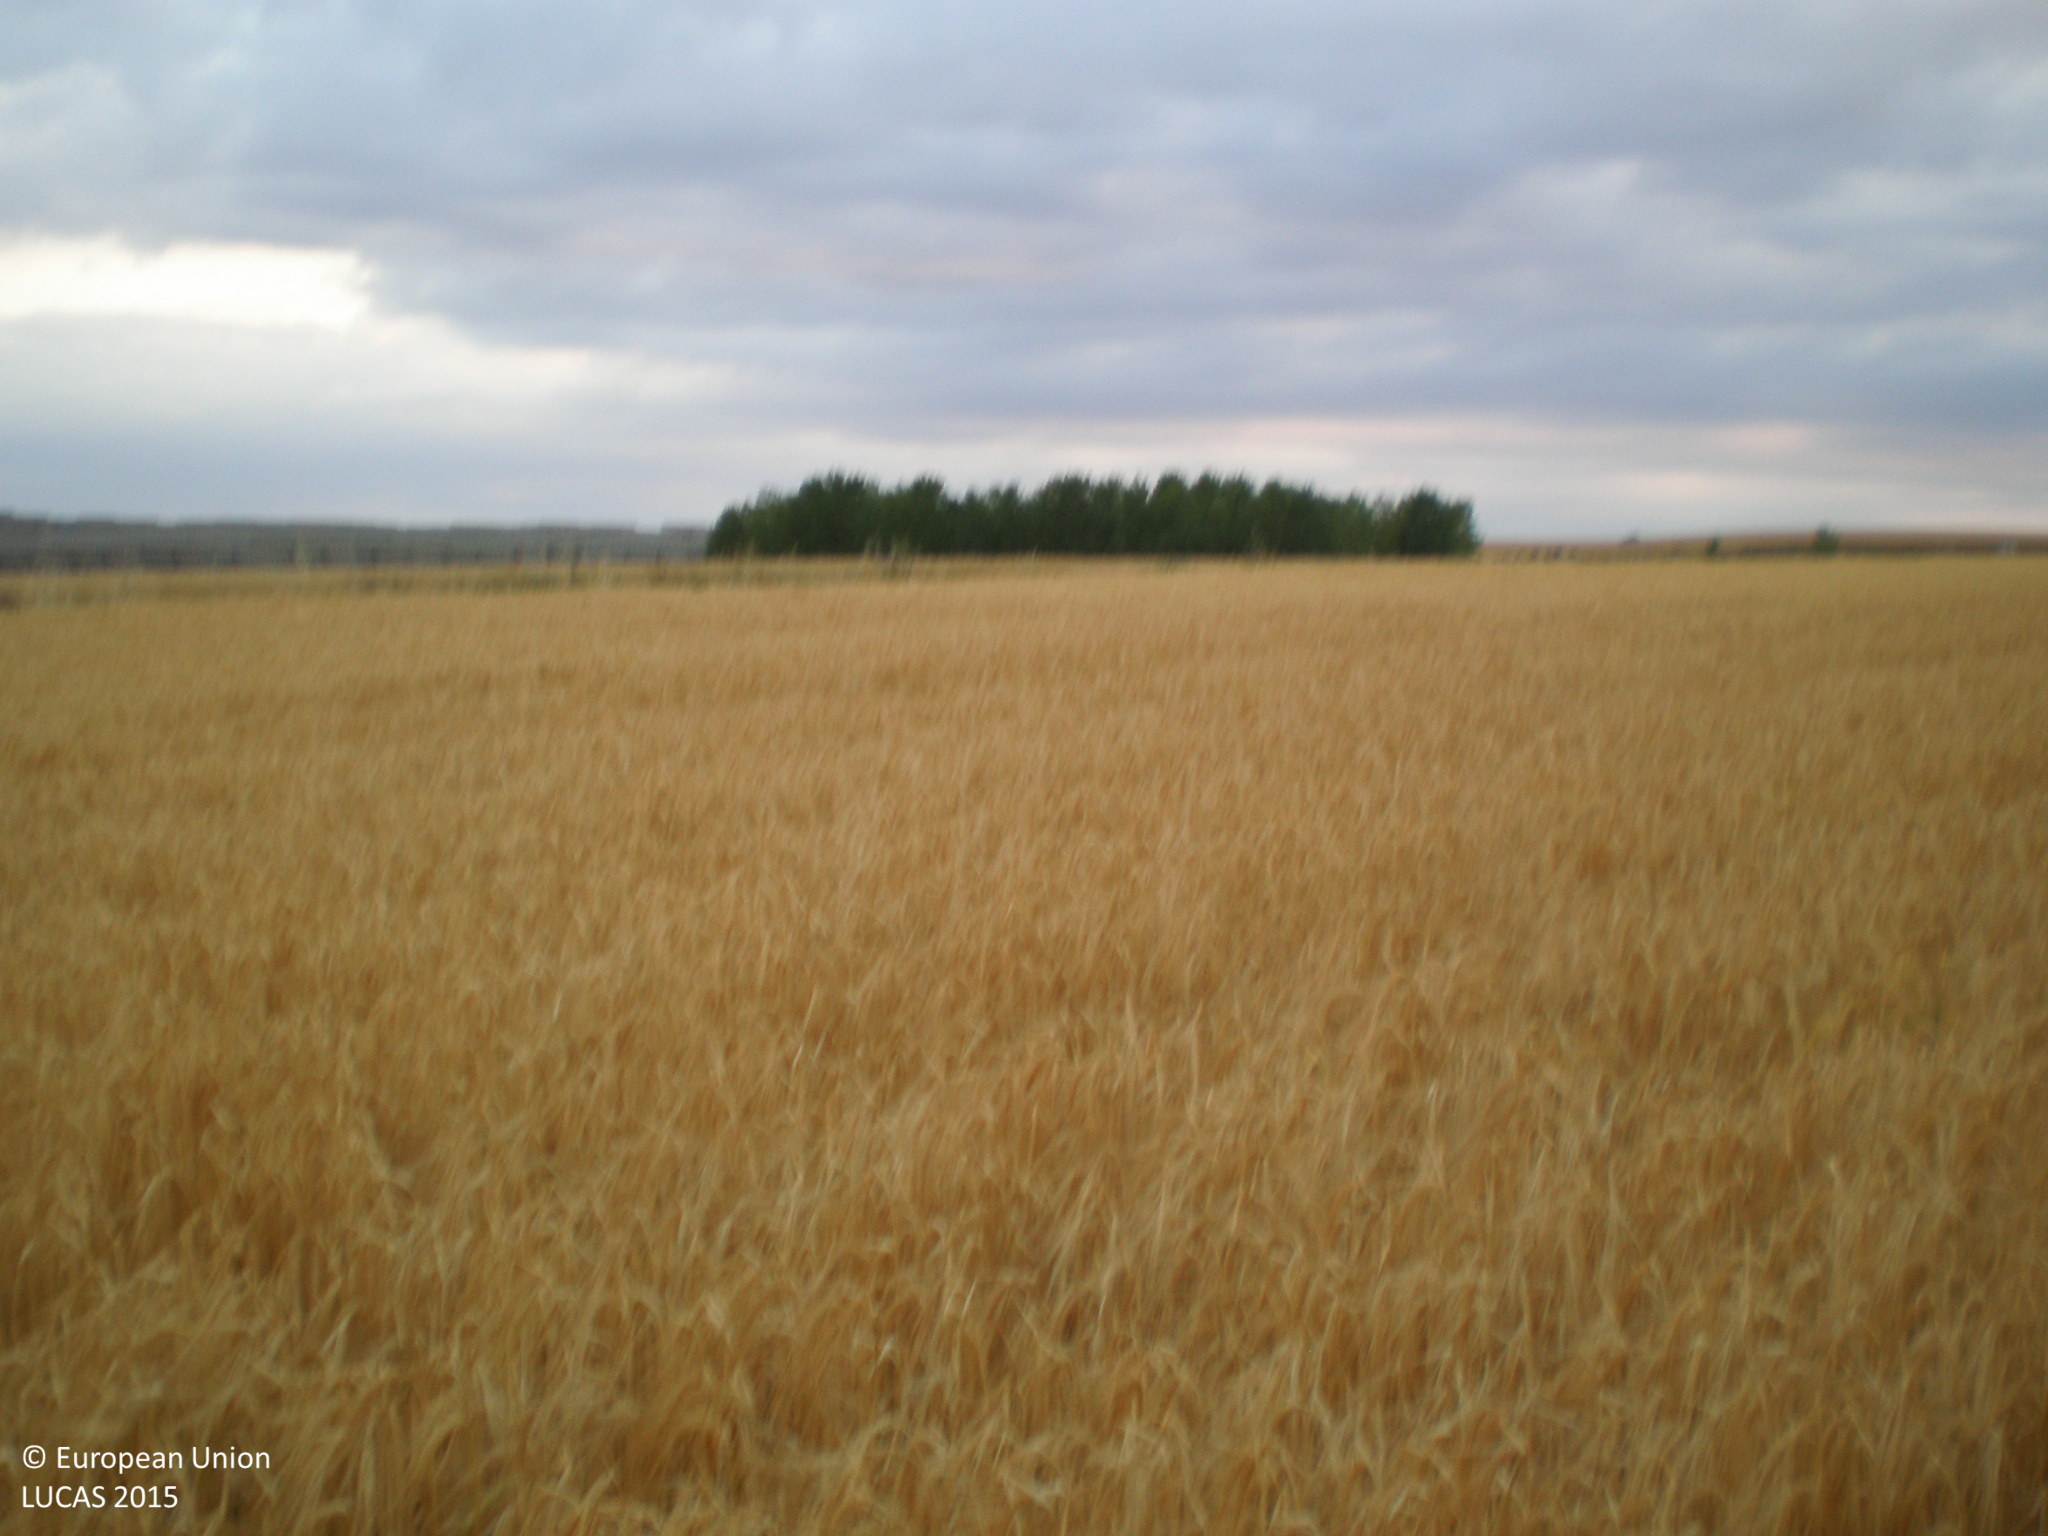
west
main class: Cropland
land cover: Barley
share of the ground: > 75 %
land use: Agriculture (excluding fallow land and kitchen gardens)
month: June
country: ES
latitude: 41.0596
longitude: -5.7759
